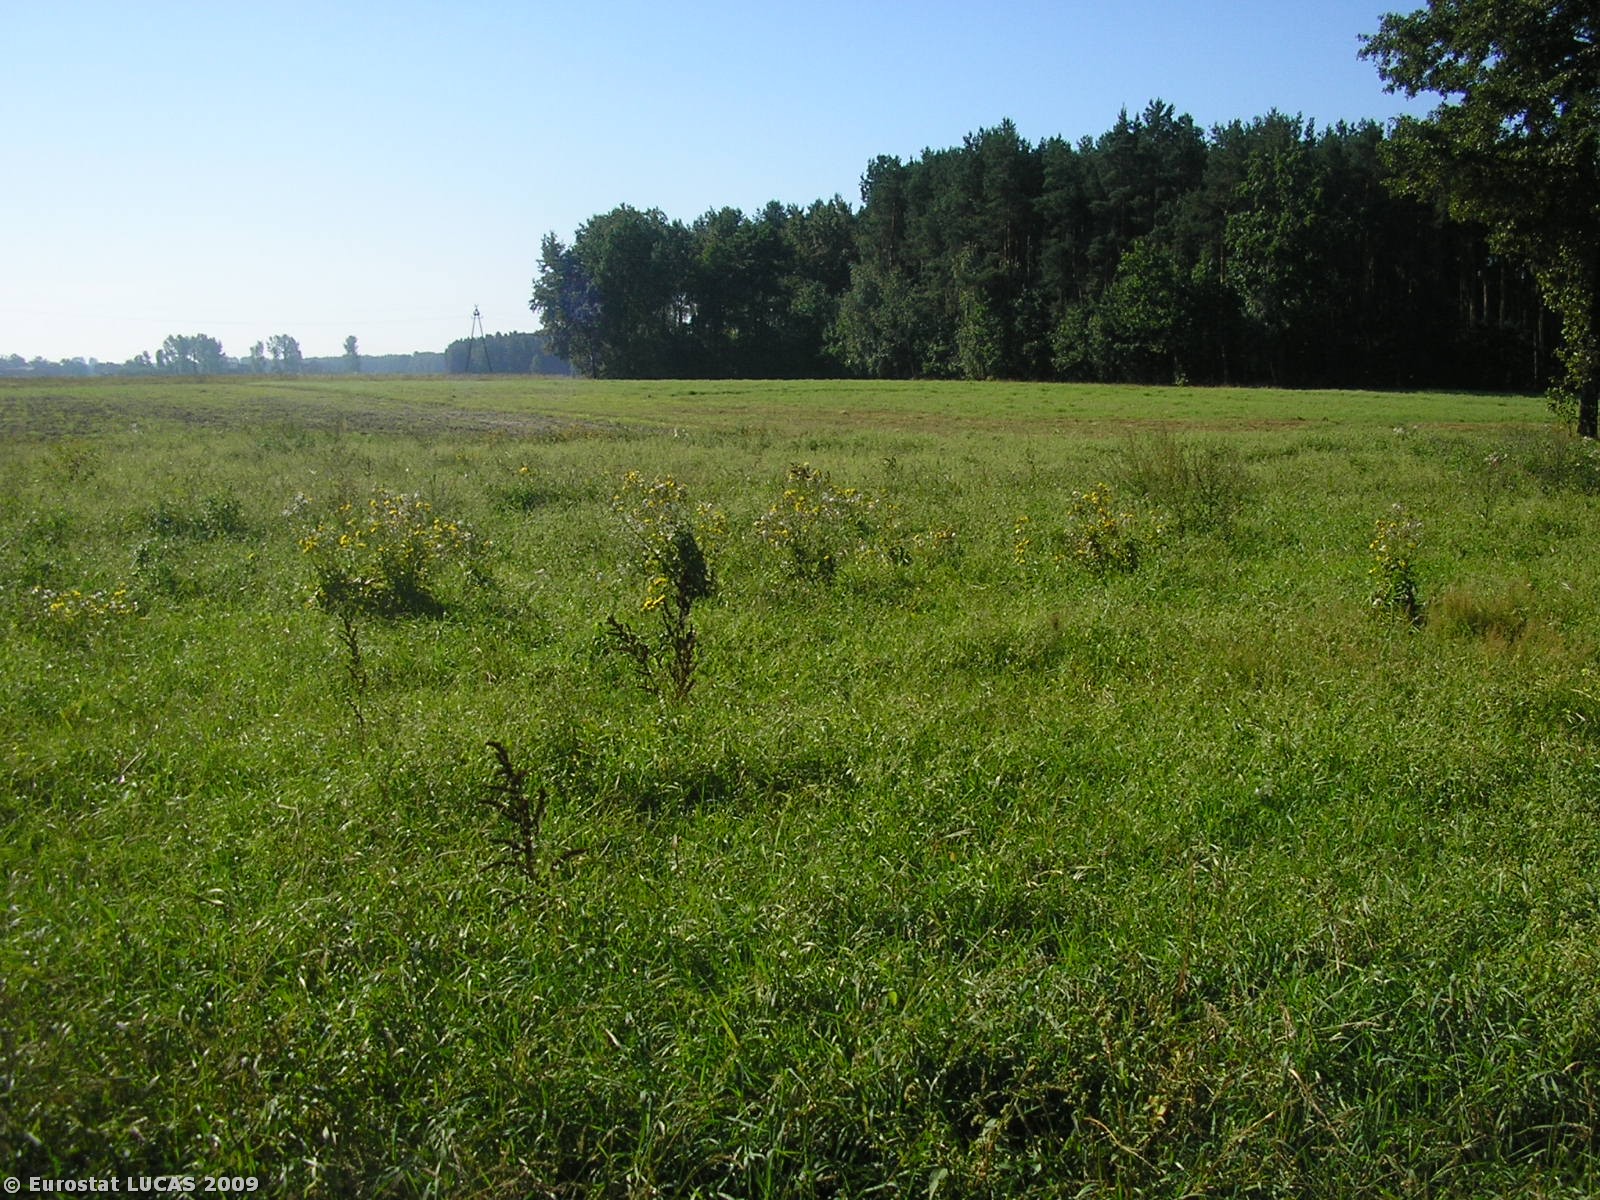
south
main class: Cropland
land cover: Potatoes
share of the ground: 25 - 50 %
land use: Agriculture (excluding fallow land and kitchen gardens)
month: September
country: PL
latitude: 51.9617
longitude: 19.4727
